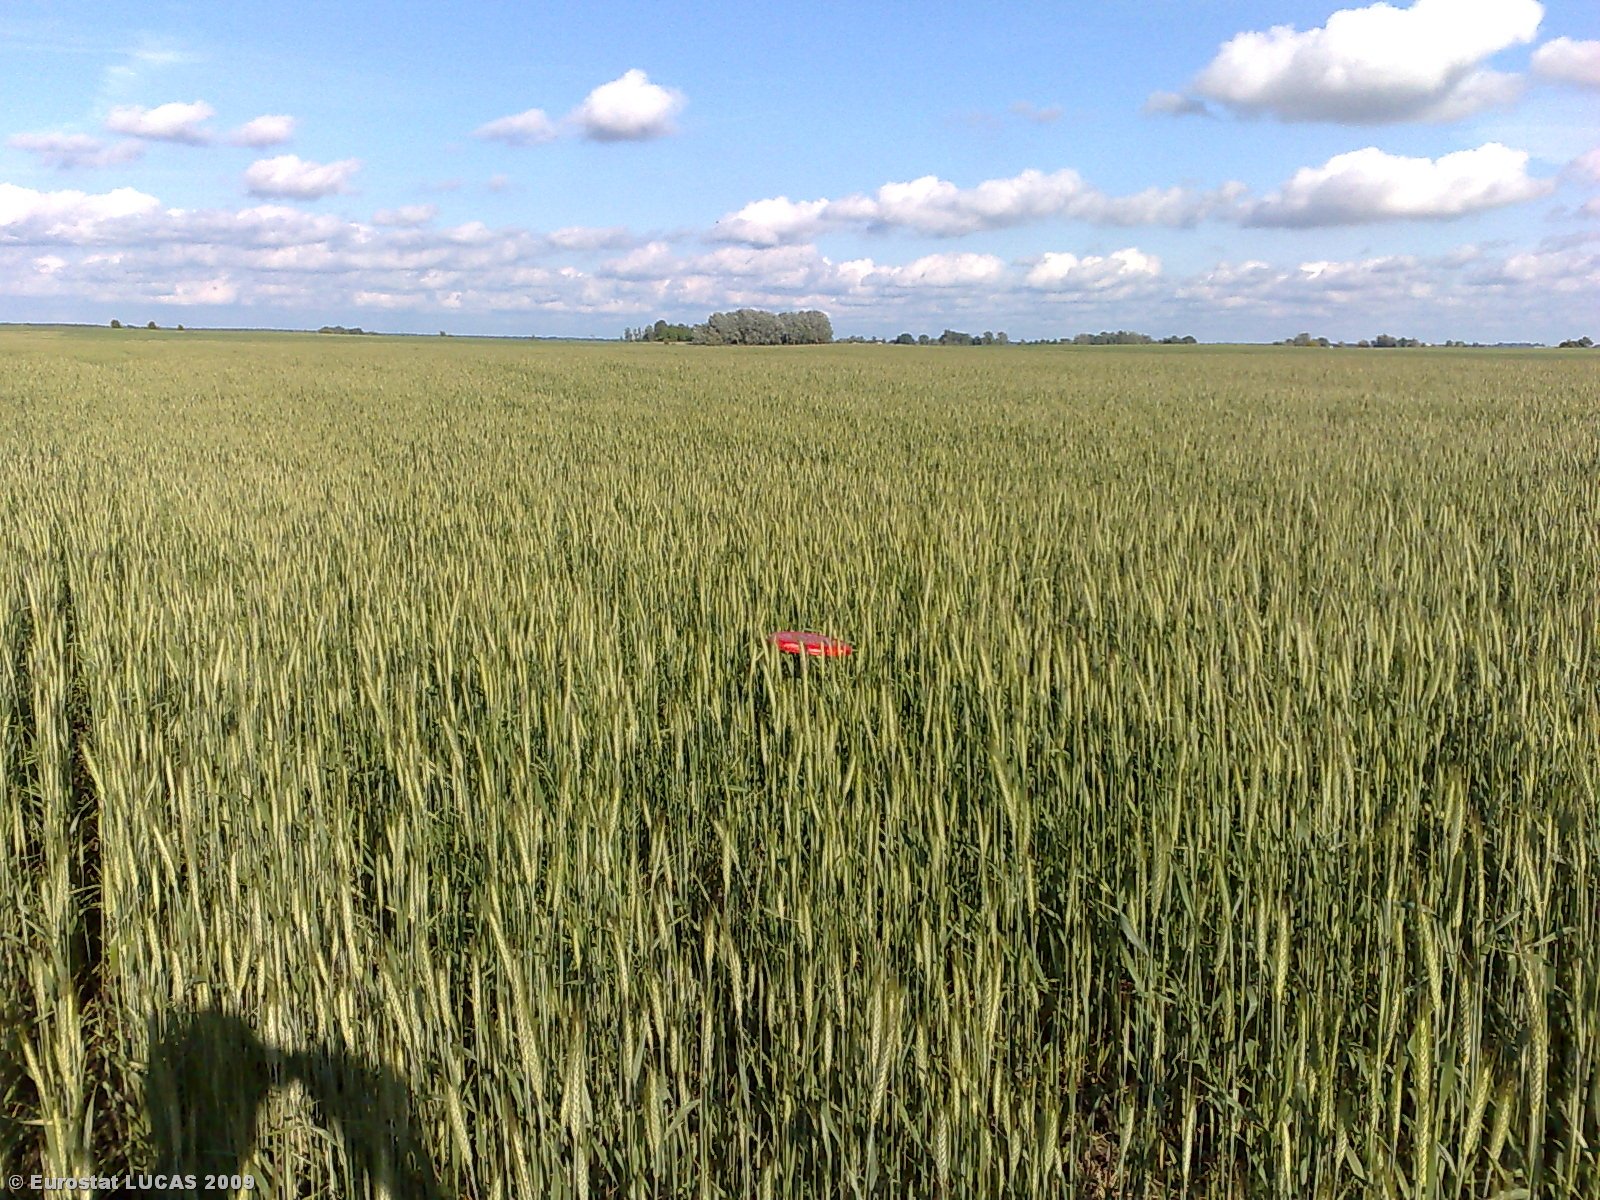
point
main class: Cropland
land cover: Rye
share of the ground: > 75 %
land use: Agriculture (excluding fallow land and kitchen gardens)
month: June
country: LT
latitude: 56.1698
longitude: 23.9524
